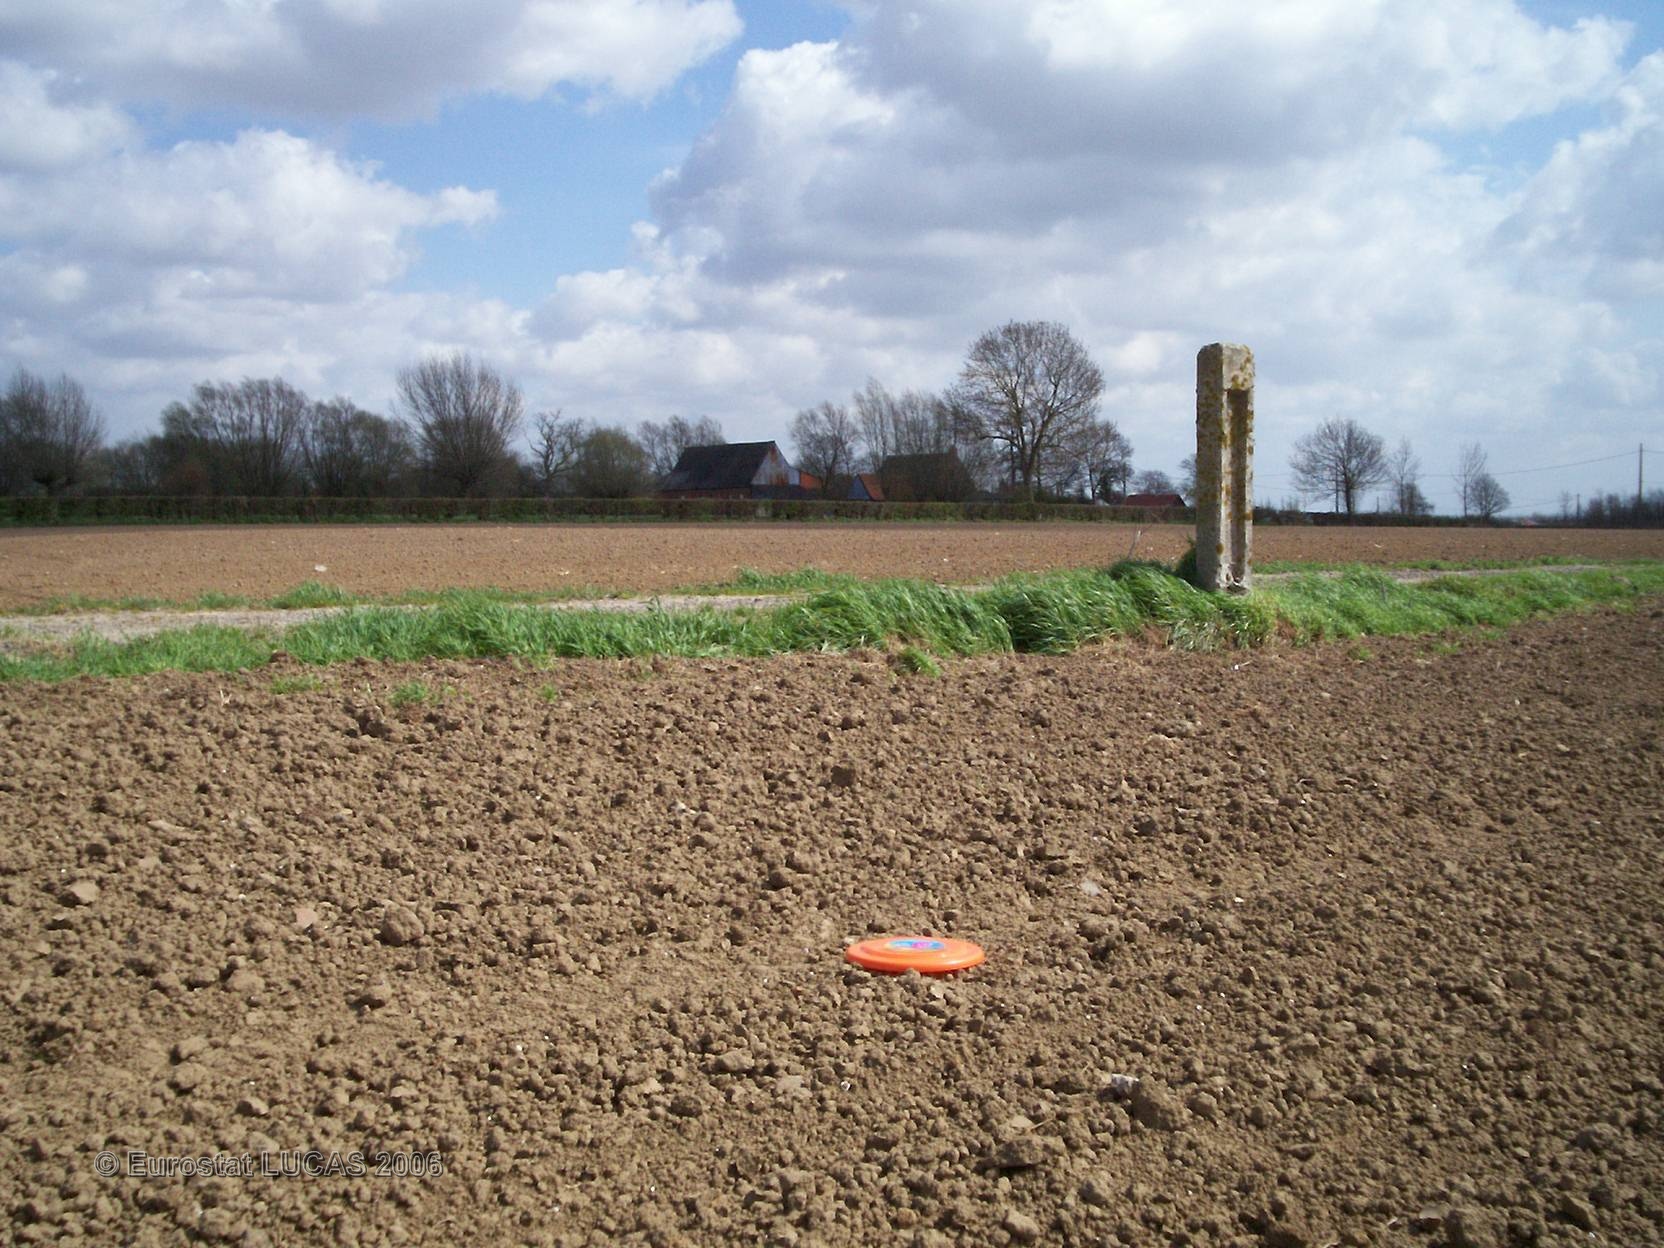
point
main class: Cropland
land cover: Sugar beet
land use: Agriculture (excluding fallow land and kitchen gardens)
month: May
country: FR
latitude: 50.8093
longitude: 2.3085
